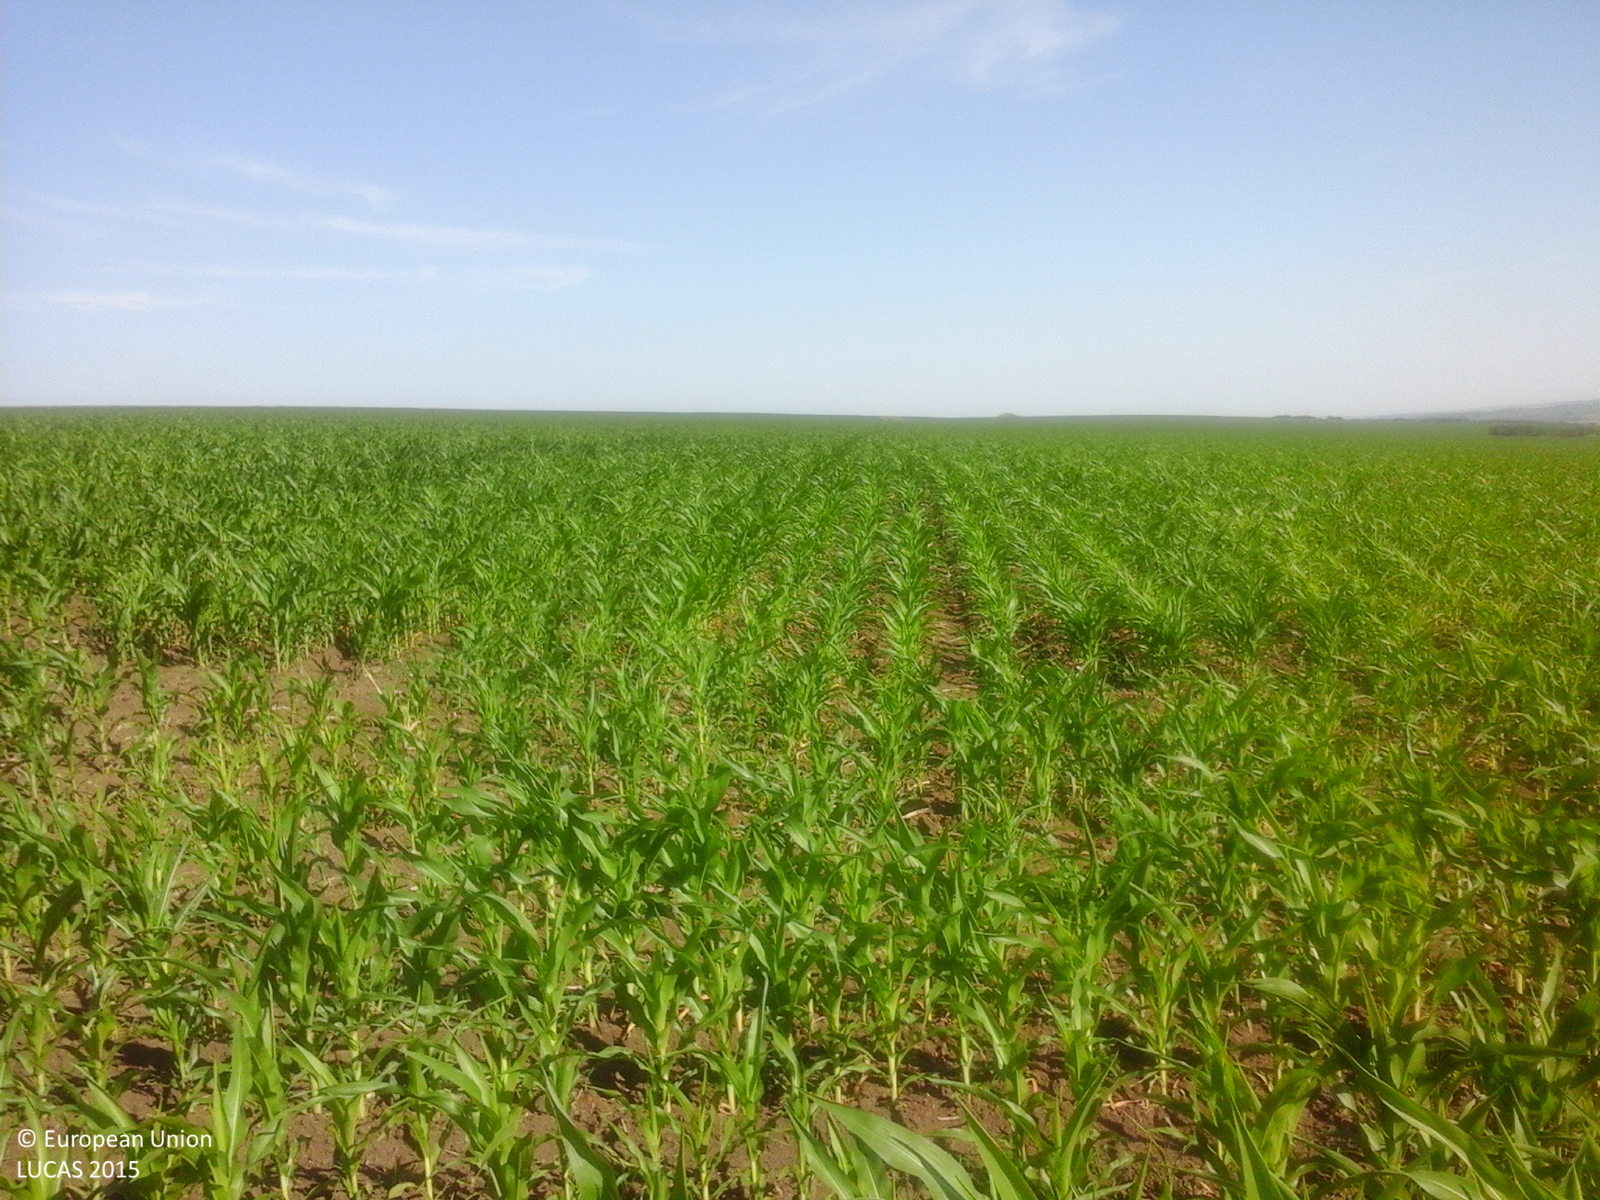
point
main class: Cropland
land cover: Maize
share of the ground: 50 - 75 %
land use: Agriculture (excluding fallow land and kitchen gardens)
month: June
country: RO
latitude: 47.8806
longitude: 27.1320
